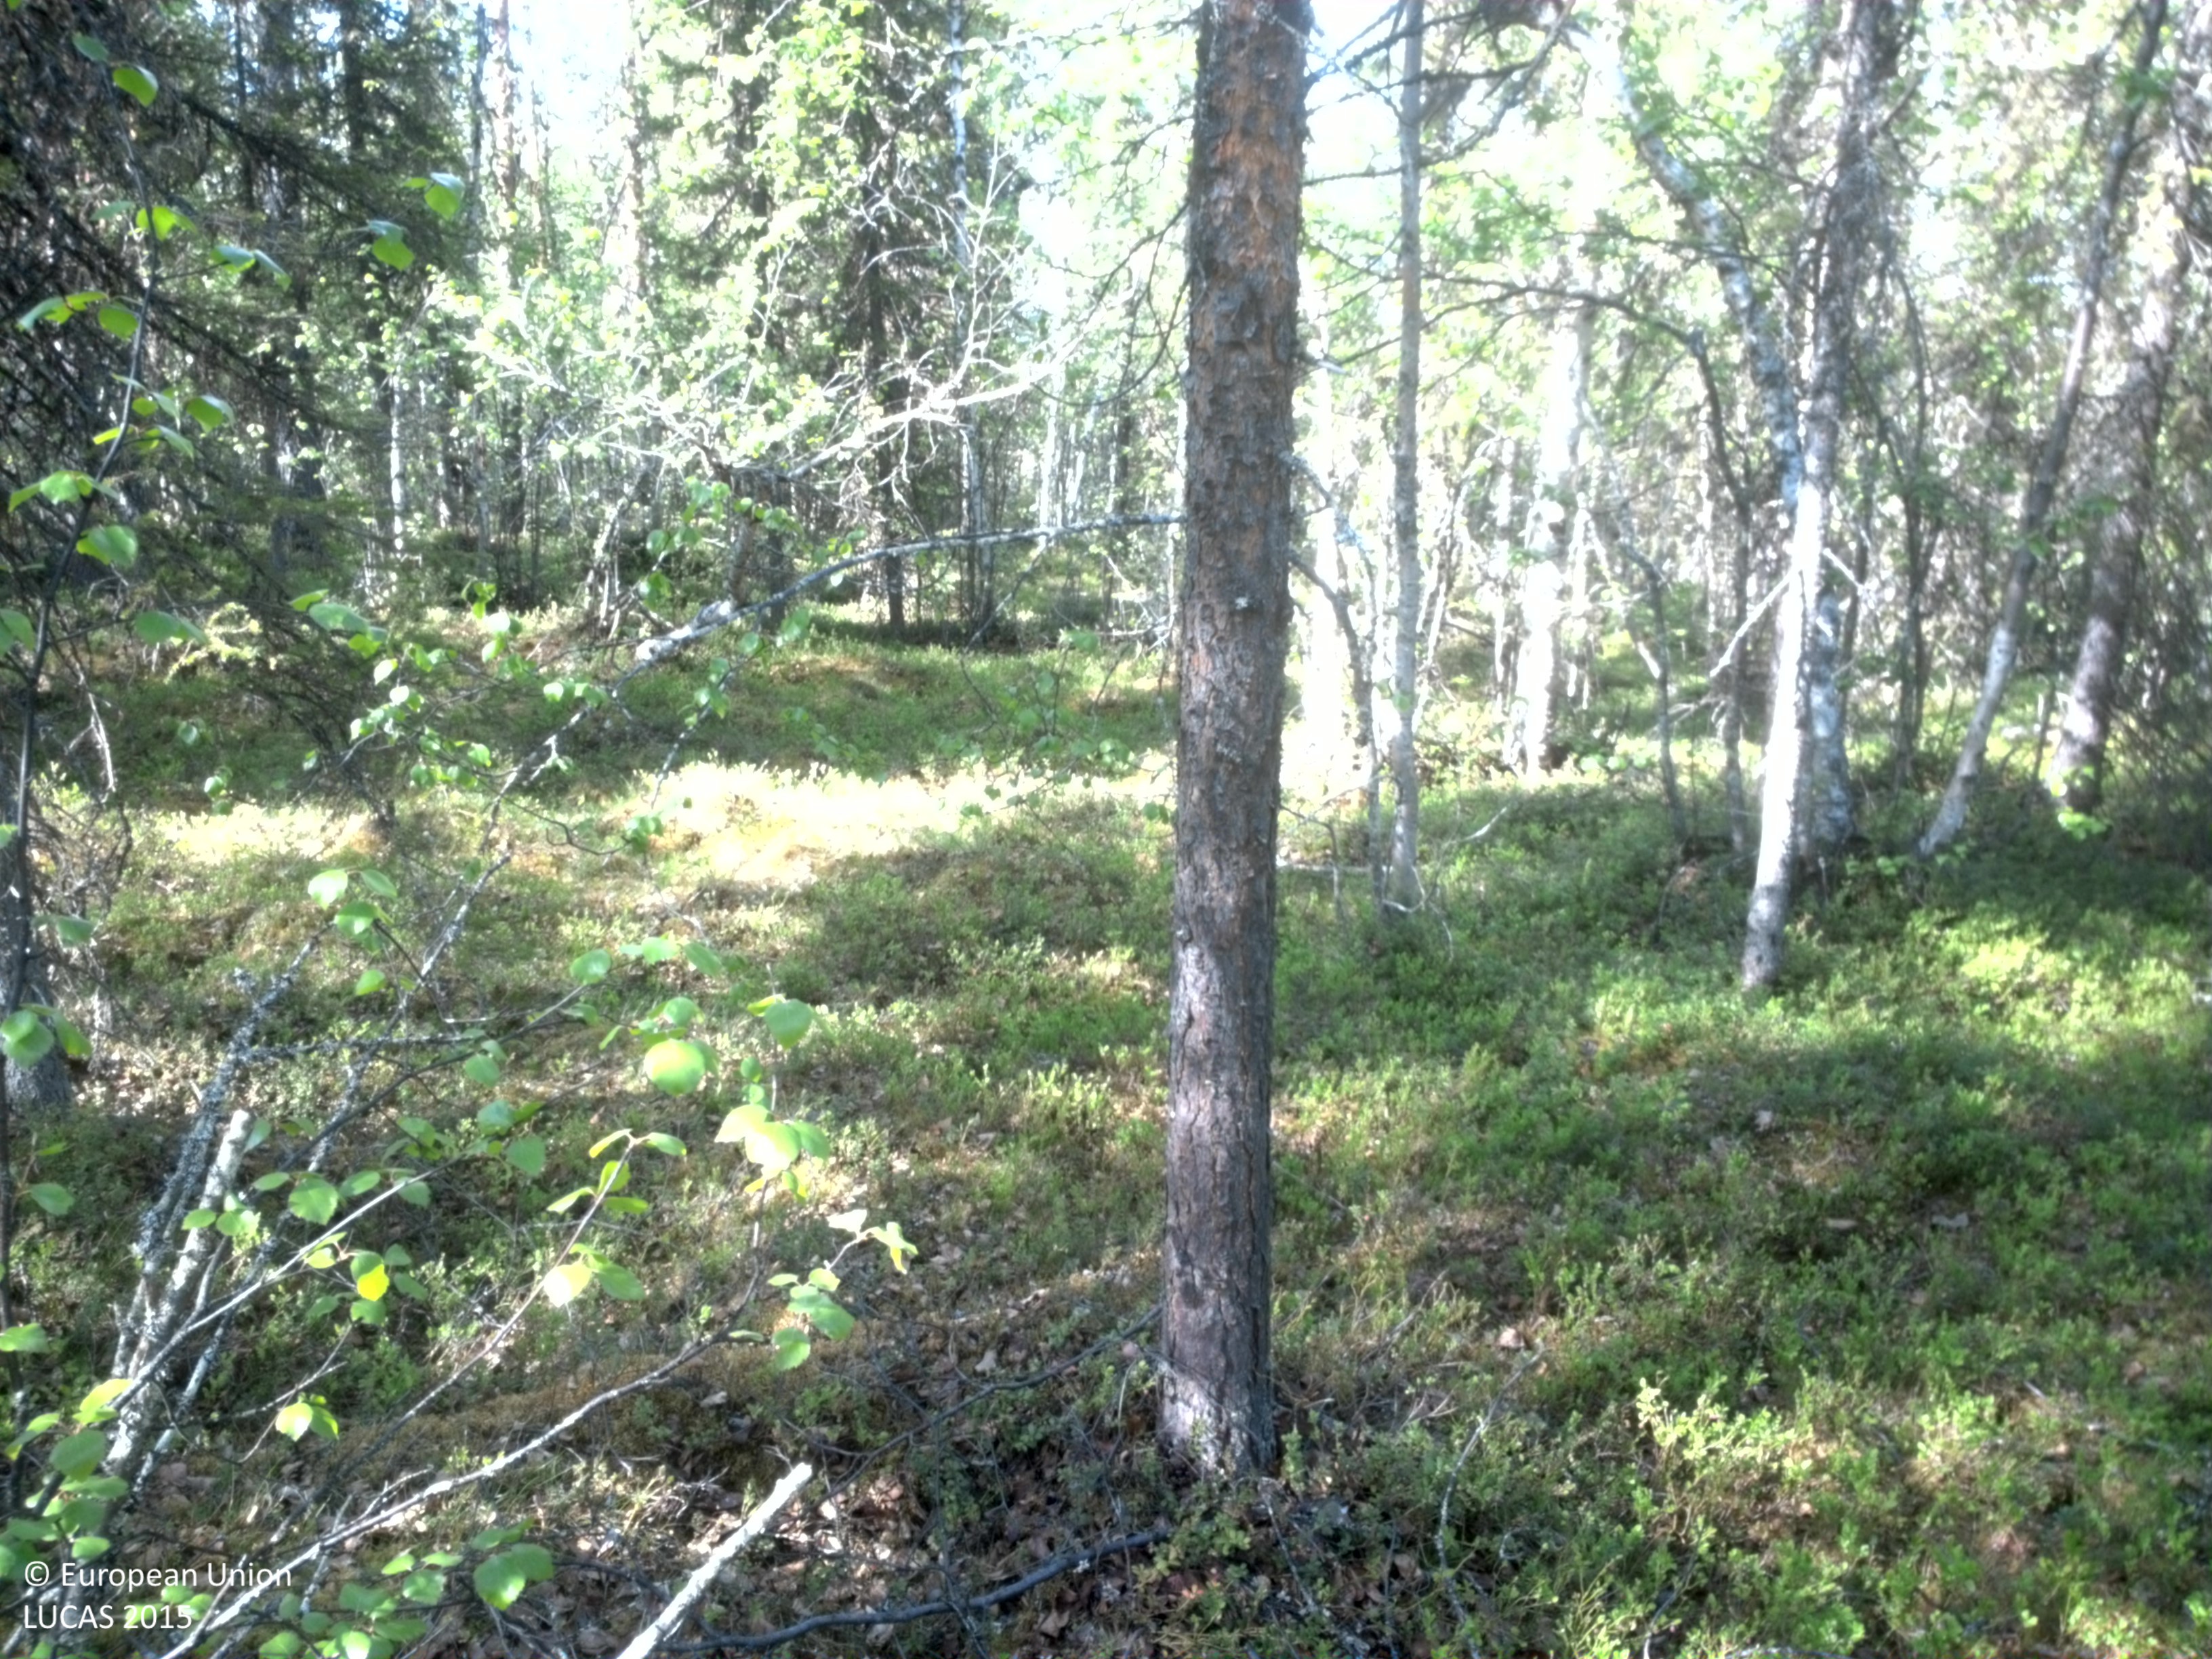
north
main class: Woodland
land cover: Other mixed woodland
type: boreal forest
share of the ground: 50 - 75 %
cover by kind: shrubs 50 %, coniferous forest trees 30 %, broadleaved forest trees 20 %
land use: Forestry
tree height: > 5 m
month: June
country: SE
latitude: 67.1705
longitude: 21.4325
